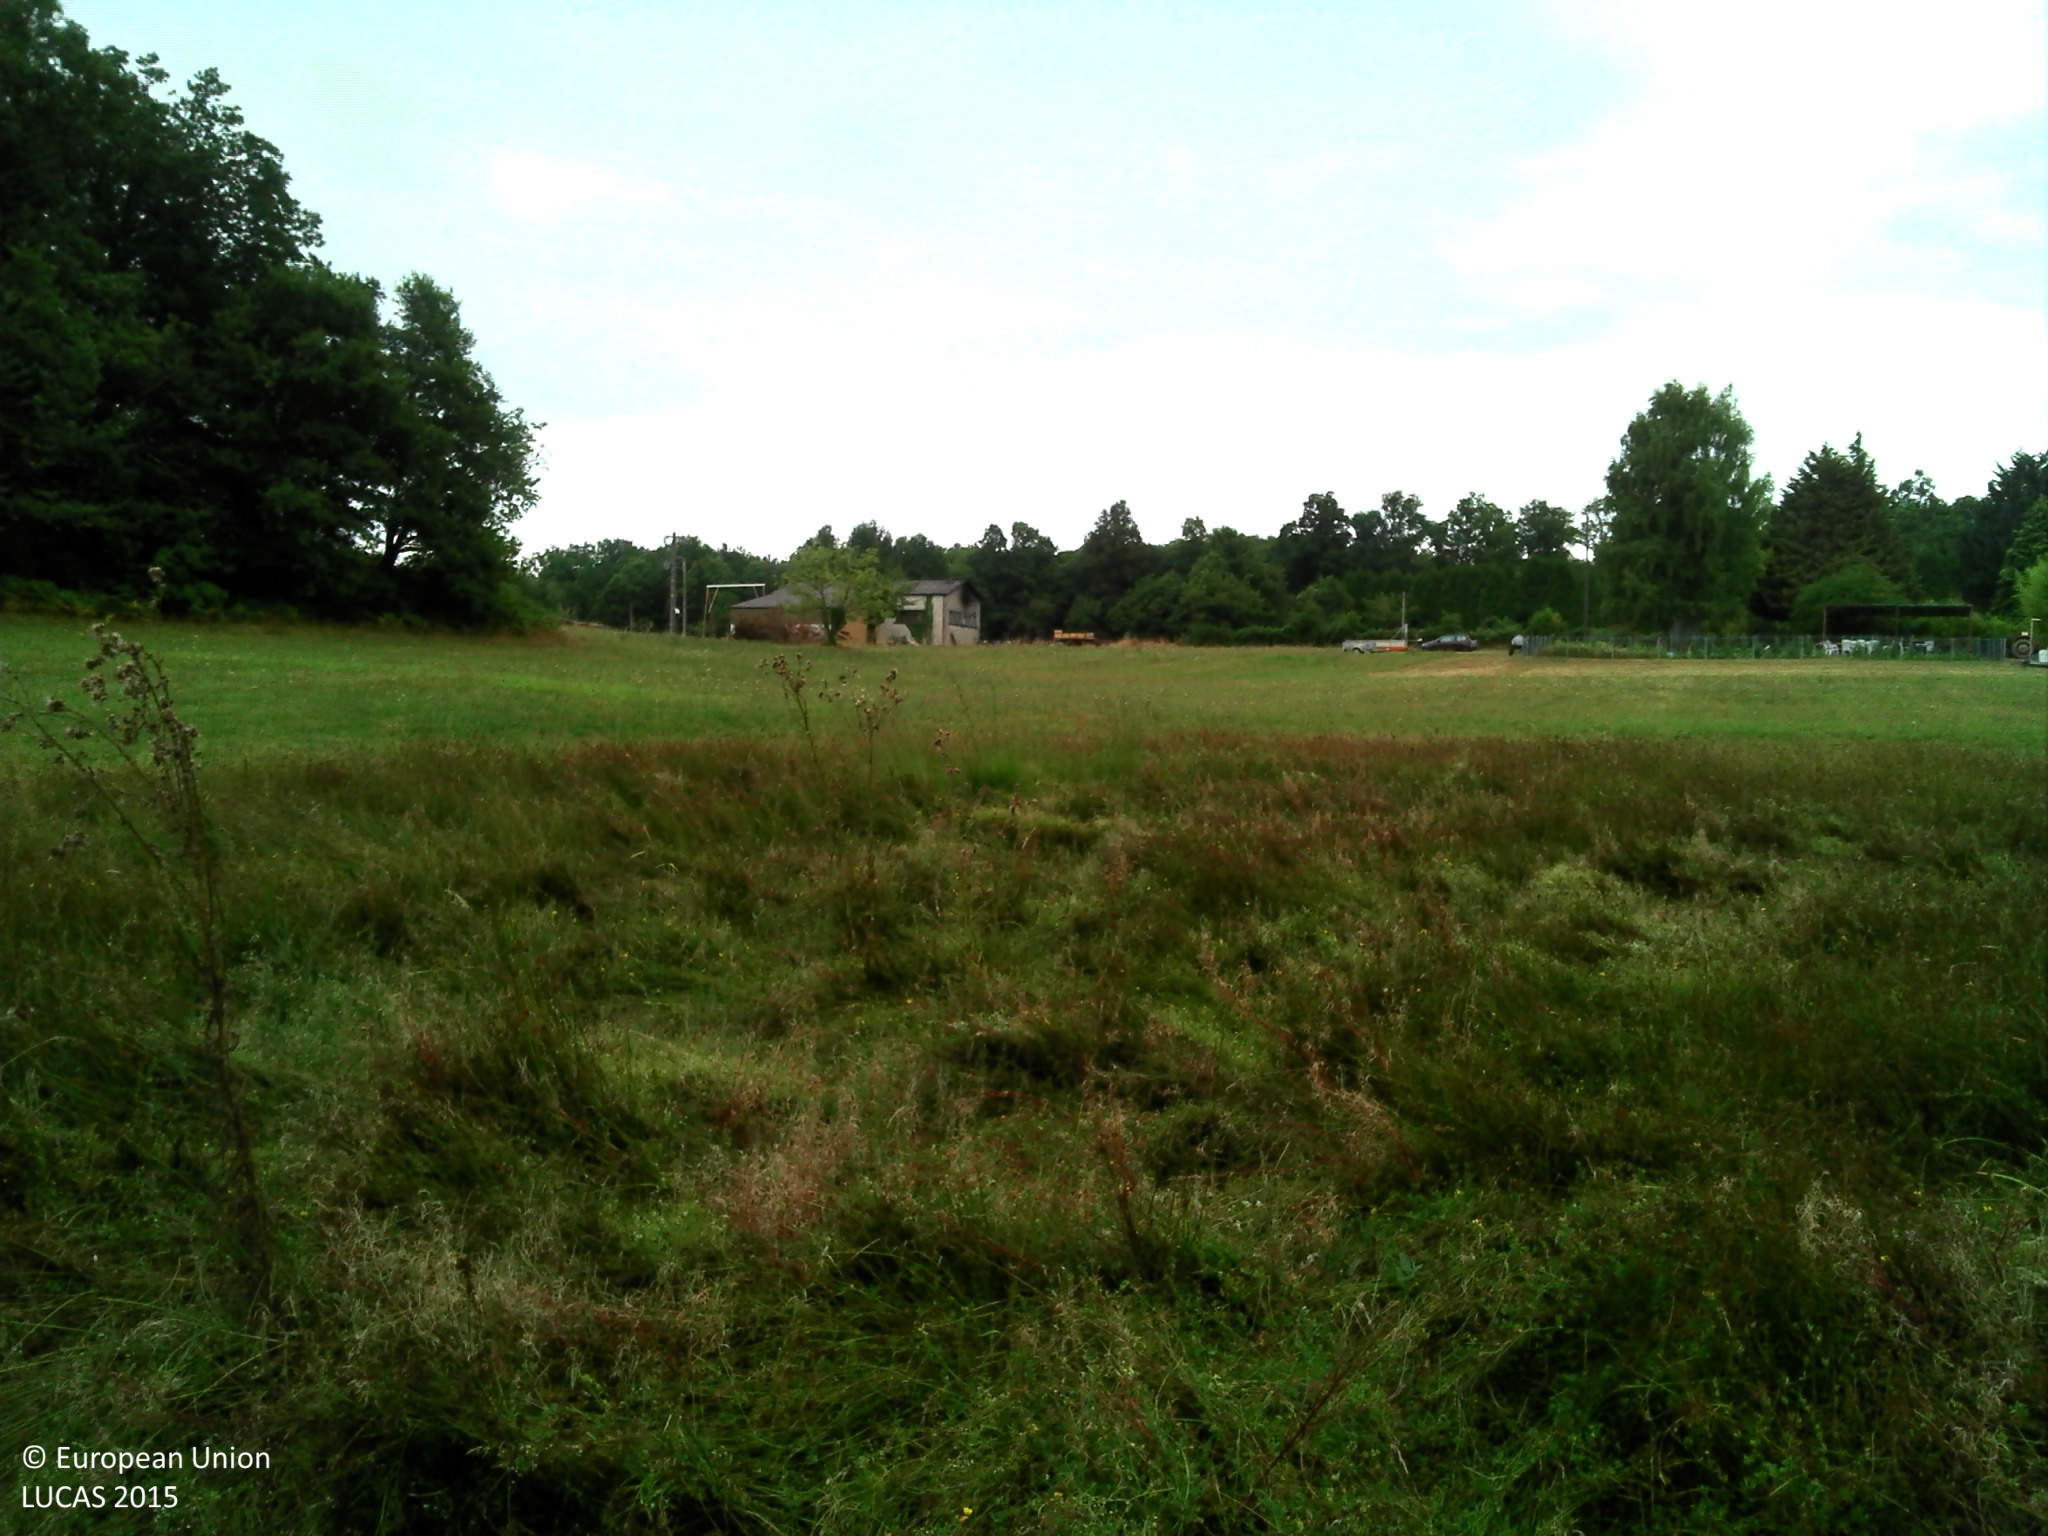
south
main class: Grassland
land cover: Grassland without tree/shrub cover
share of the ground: > 75 %
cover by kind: herbaceous plants 100 %
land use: Agriculture (excluding fallow land and kitchen gardens)
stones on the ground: < 10 %
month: July
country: FR
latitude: 45.5645
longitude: 0.6993
